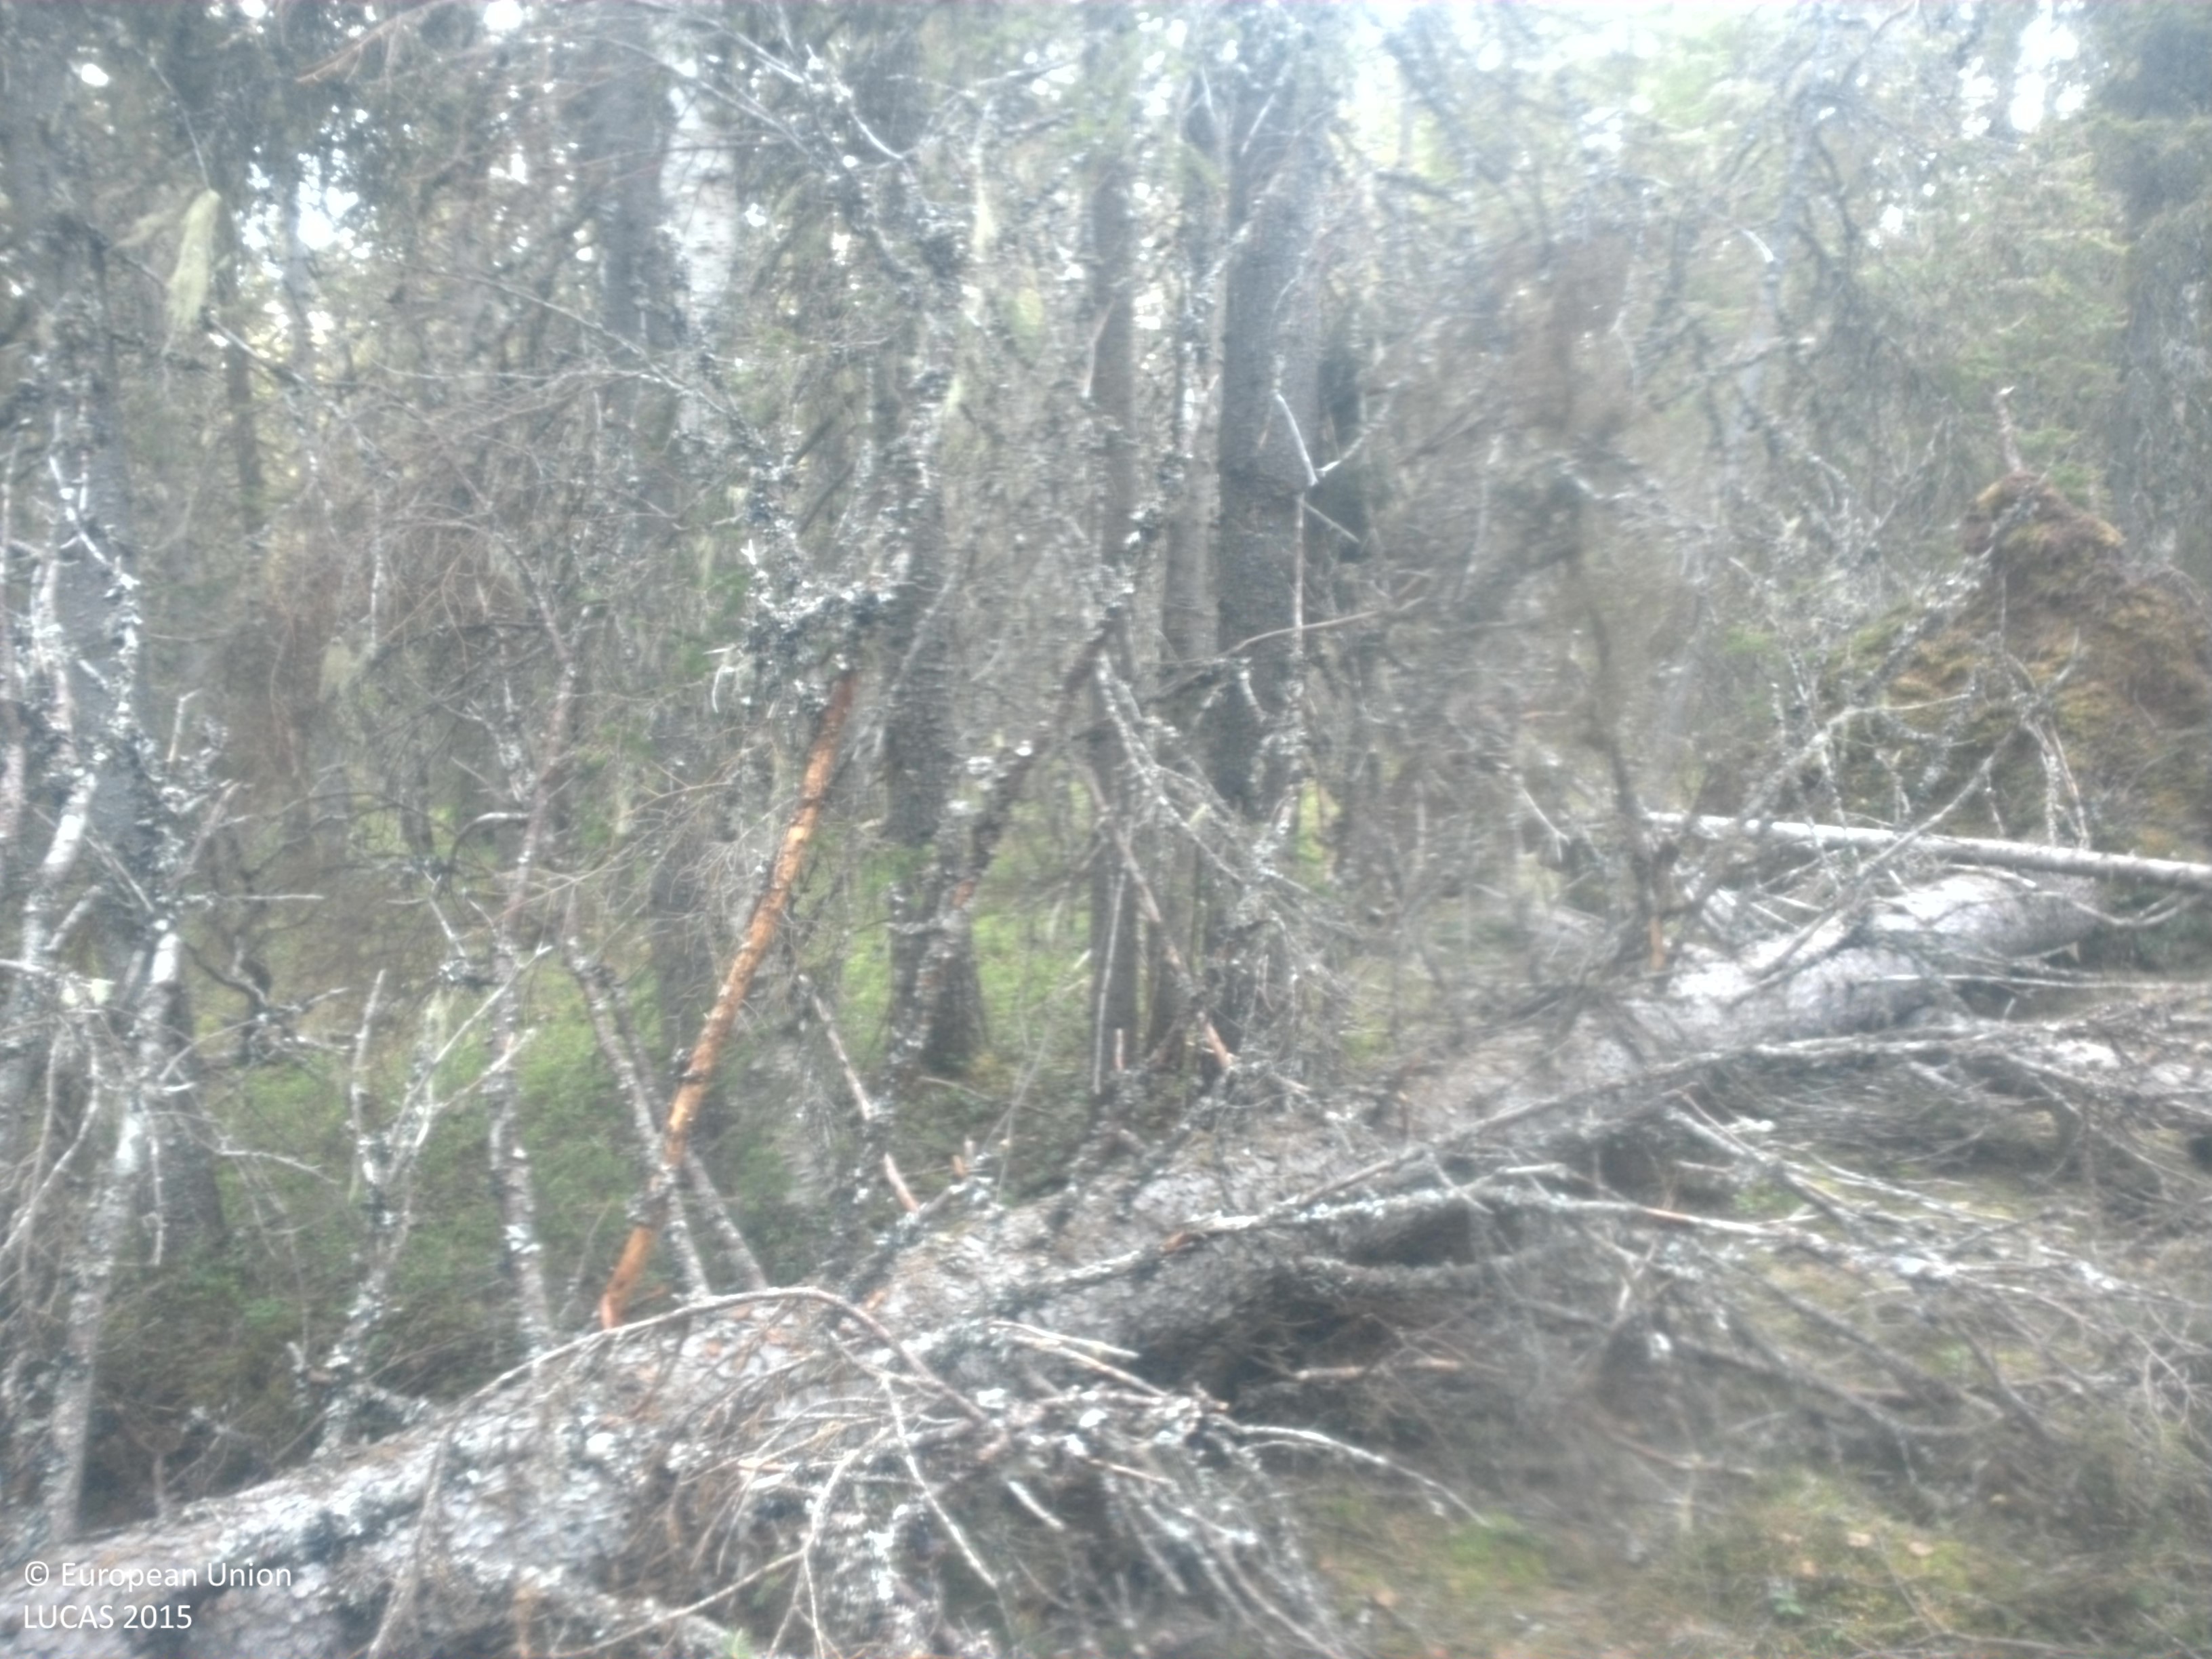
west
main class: Woodland
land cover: Spruce dominated coniferous woodland
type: boreal forest
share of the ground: 25 - 50 %
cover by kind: coniferous forest trees 45 %, herbaceous plants 25 %, lichens and mosses 10 %, unconsolidated bare surface 10 %, broadleaved forest trees 5 %, shrubs 5 %
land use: Forestry
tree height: > 5 m
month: June
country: SE
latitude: 64.4463
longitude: 17.7178
